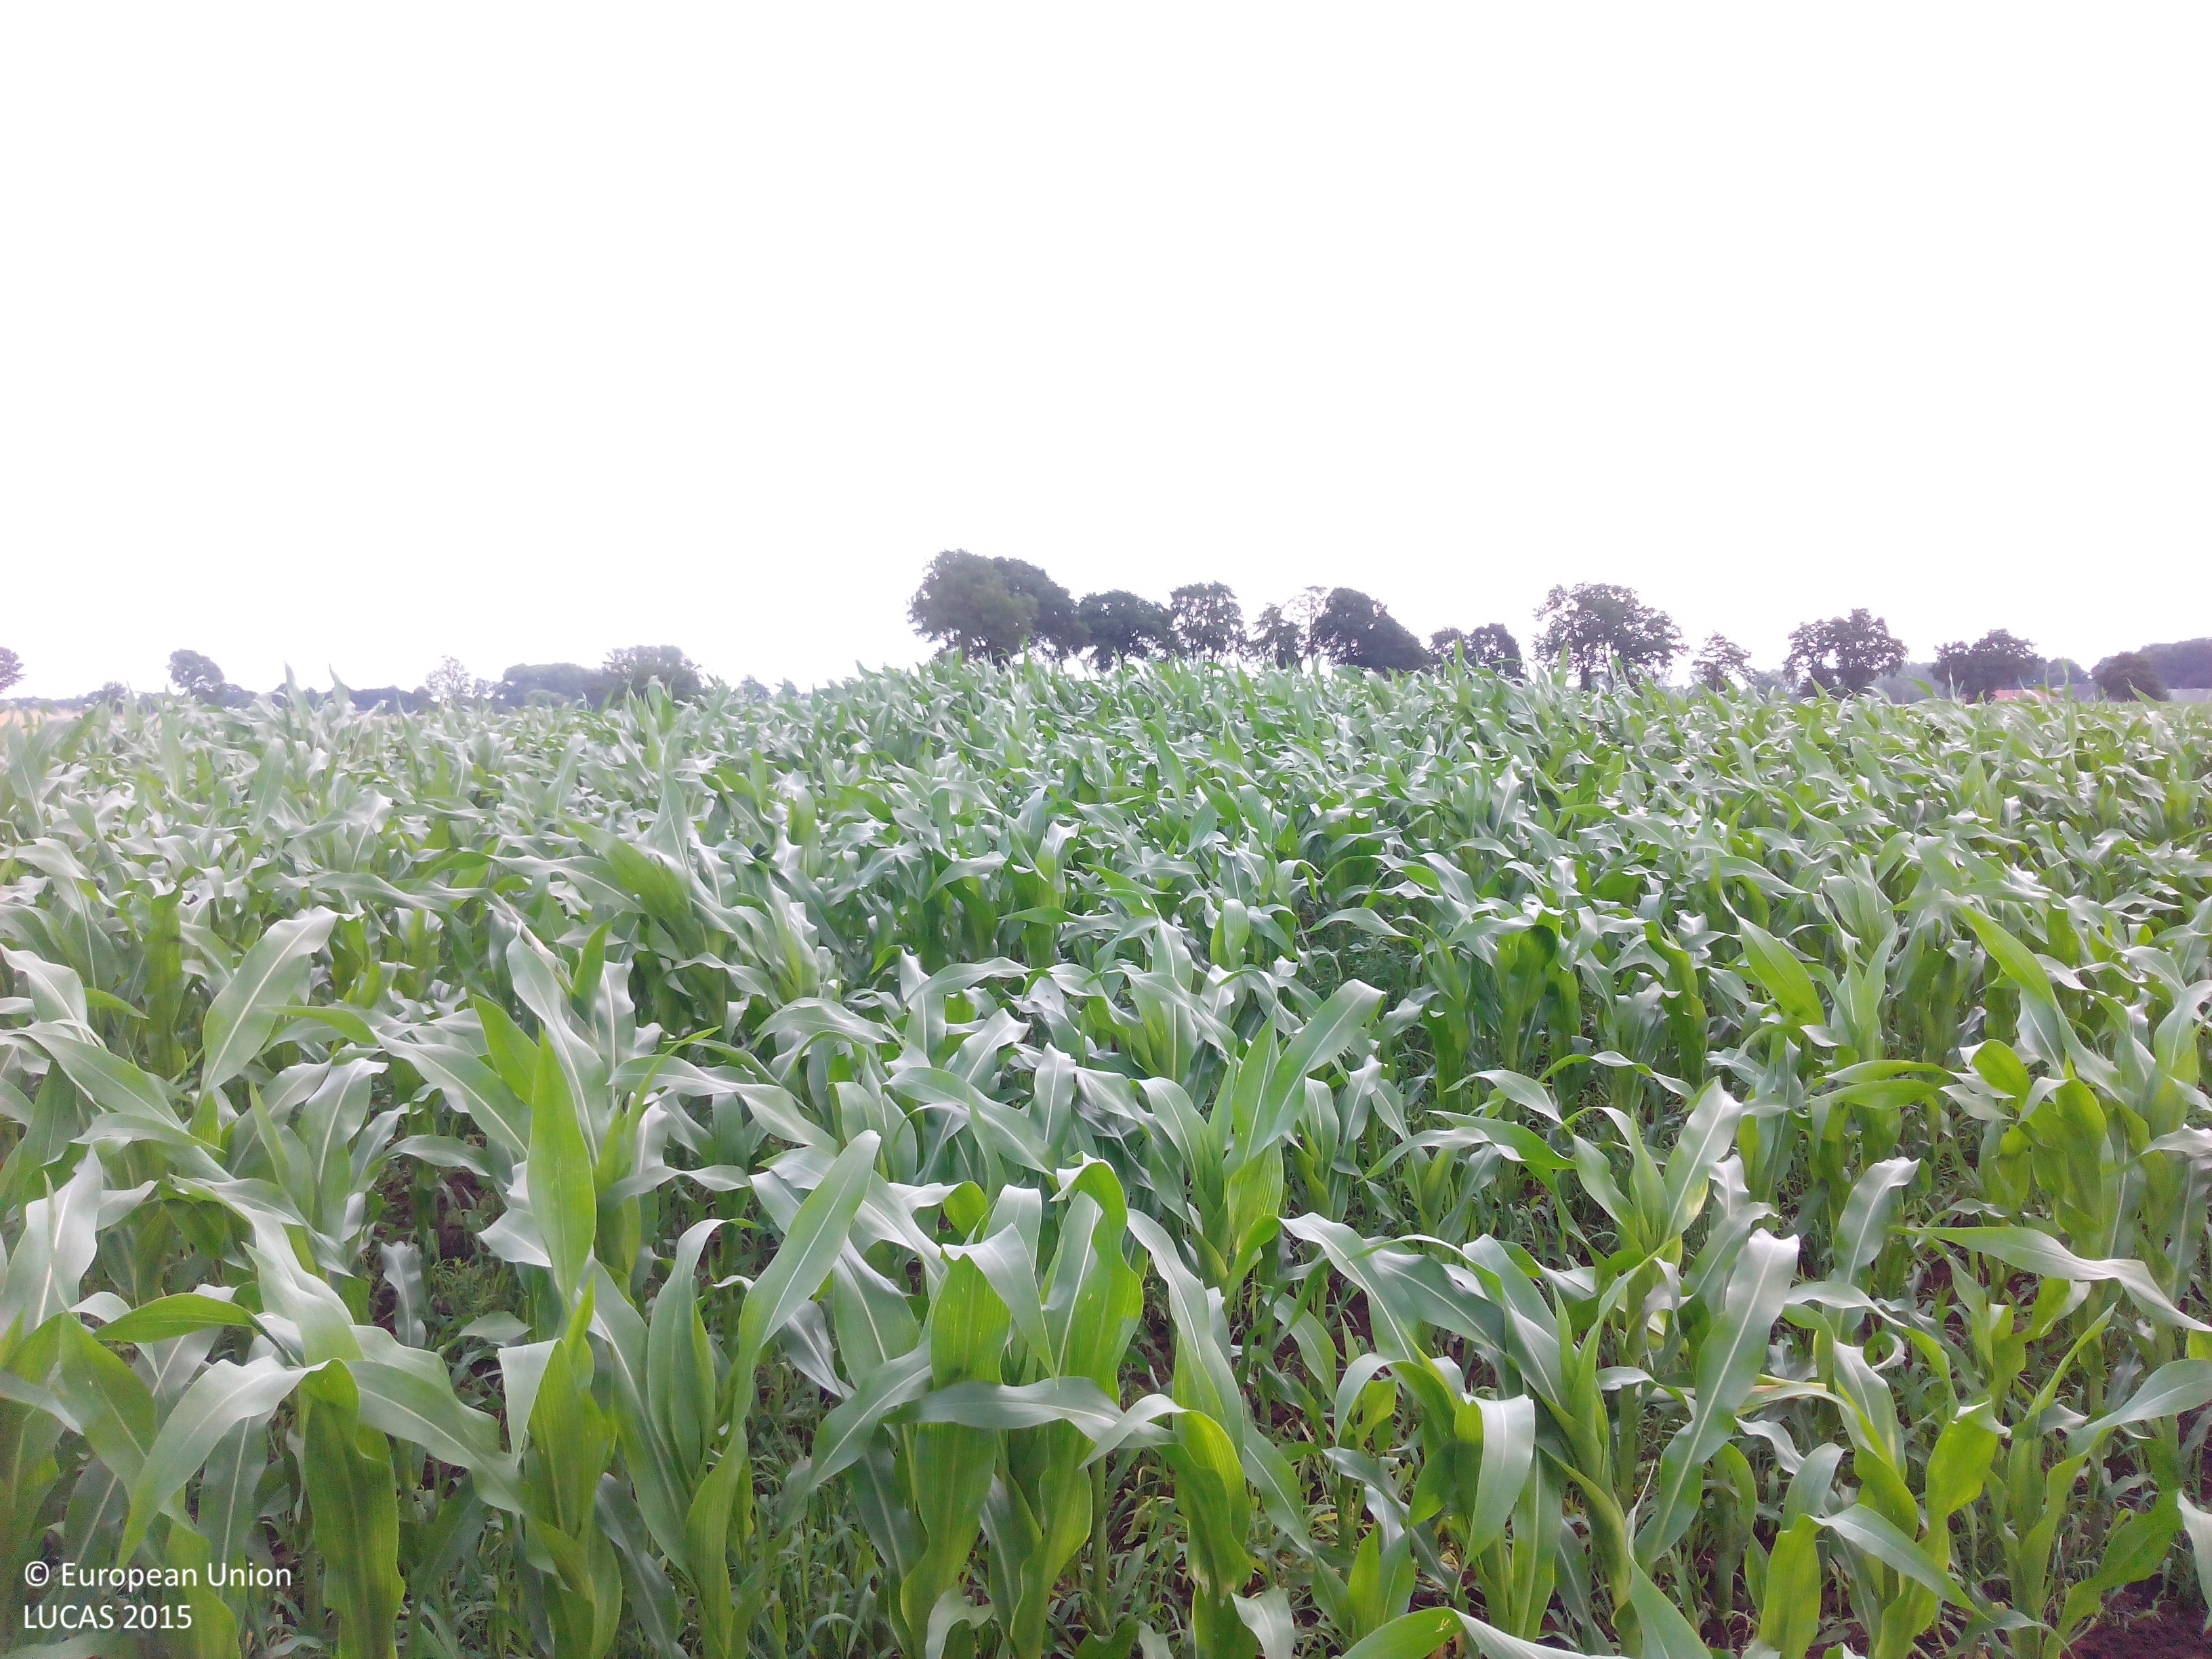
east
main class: Cropland
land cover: Maize
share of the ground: > 75 %
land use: Agriculture (excluding fallow land and kitchen gardens)
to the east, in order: Maize; Grass margins; Ditches and canals; Grass margins; Common wheat
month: July
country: DE
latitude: 52.6659
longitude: 7.9748
